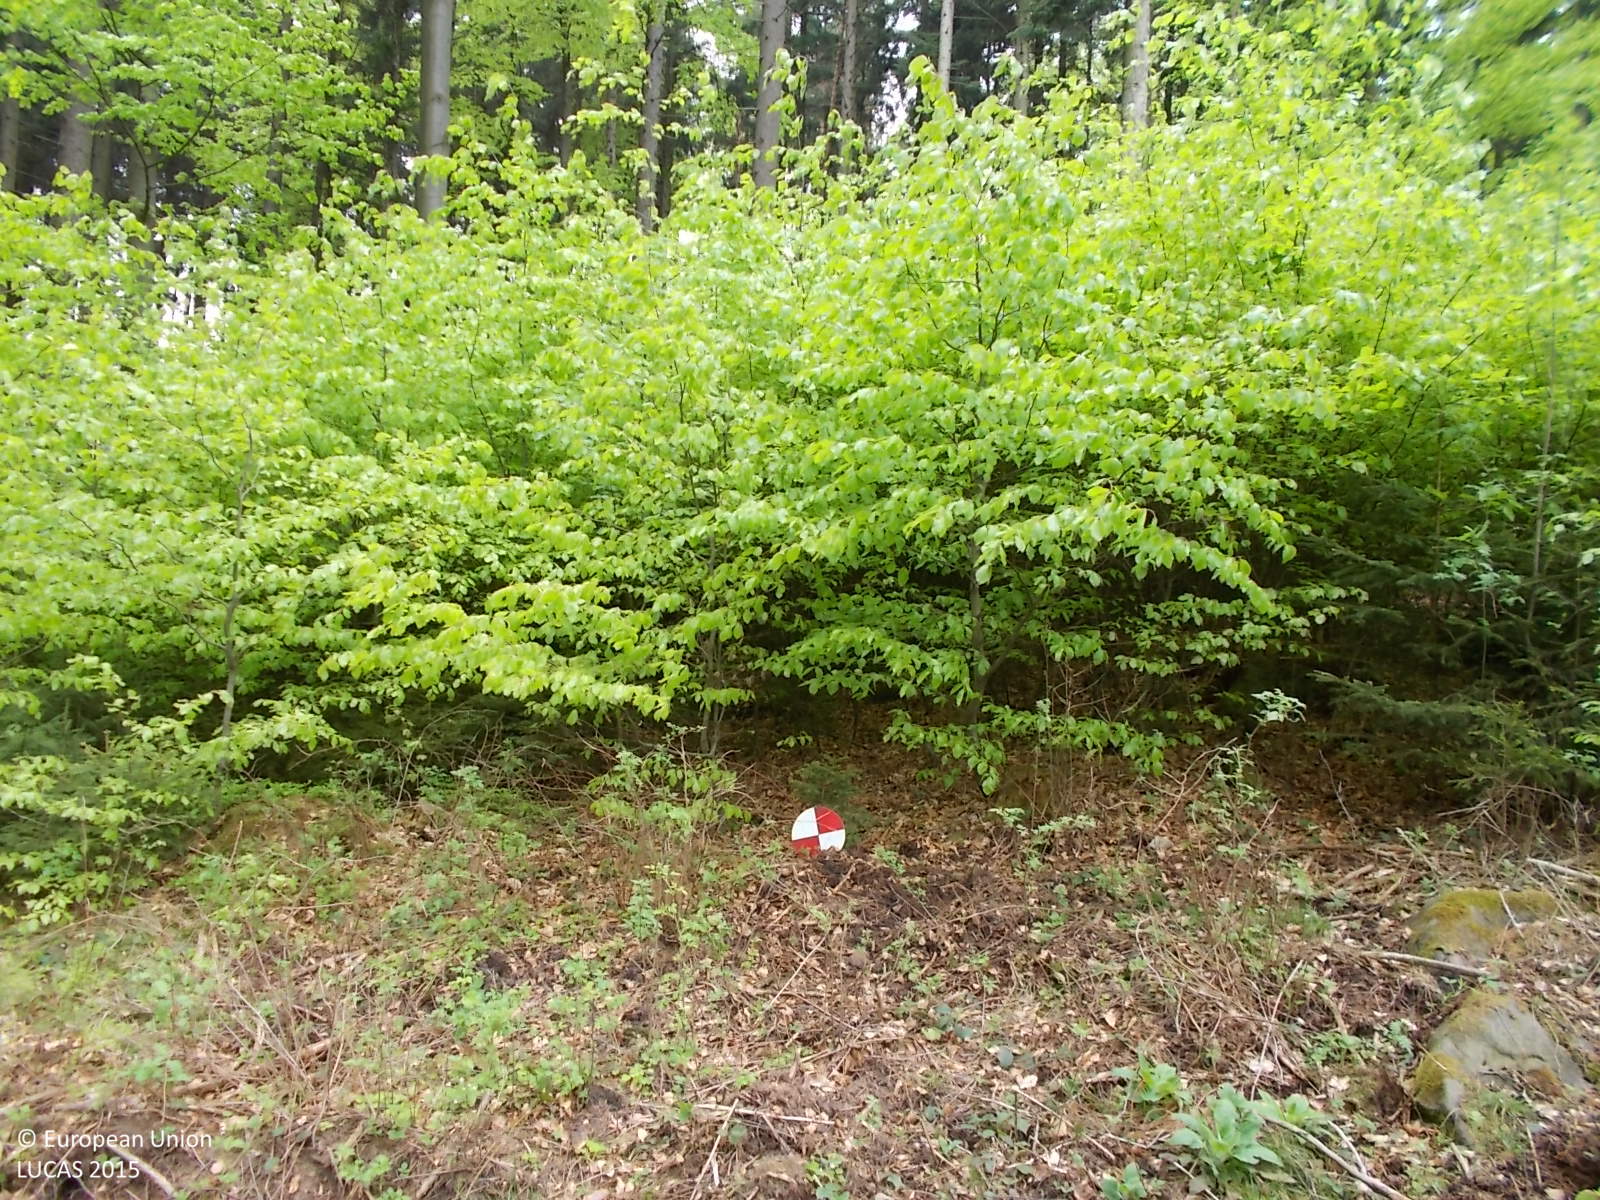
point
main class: Woodland
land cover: Other coniferous woodland
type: hemiboreal forest and nemoral coniferous forest and mixed broadleaved-coniferous forest
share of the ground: > 75 %
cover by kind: coniferous forest trees 70 %, broadleaved forest trees 20 %, herbaceous plants 5 %, lichens and mosses 5 %
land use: Forestry
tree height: > 5 m
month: May
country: CZ
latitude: 49.4742
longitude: 15.5102
